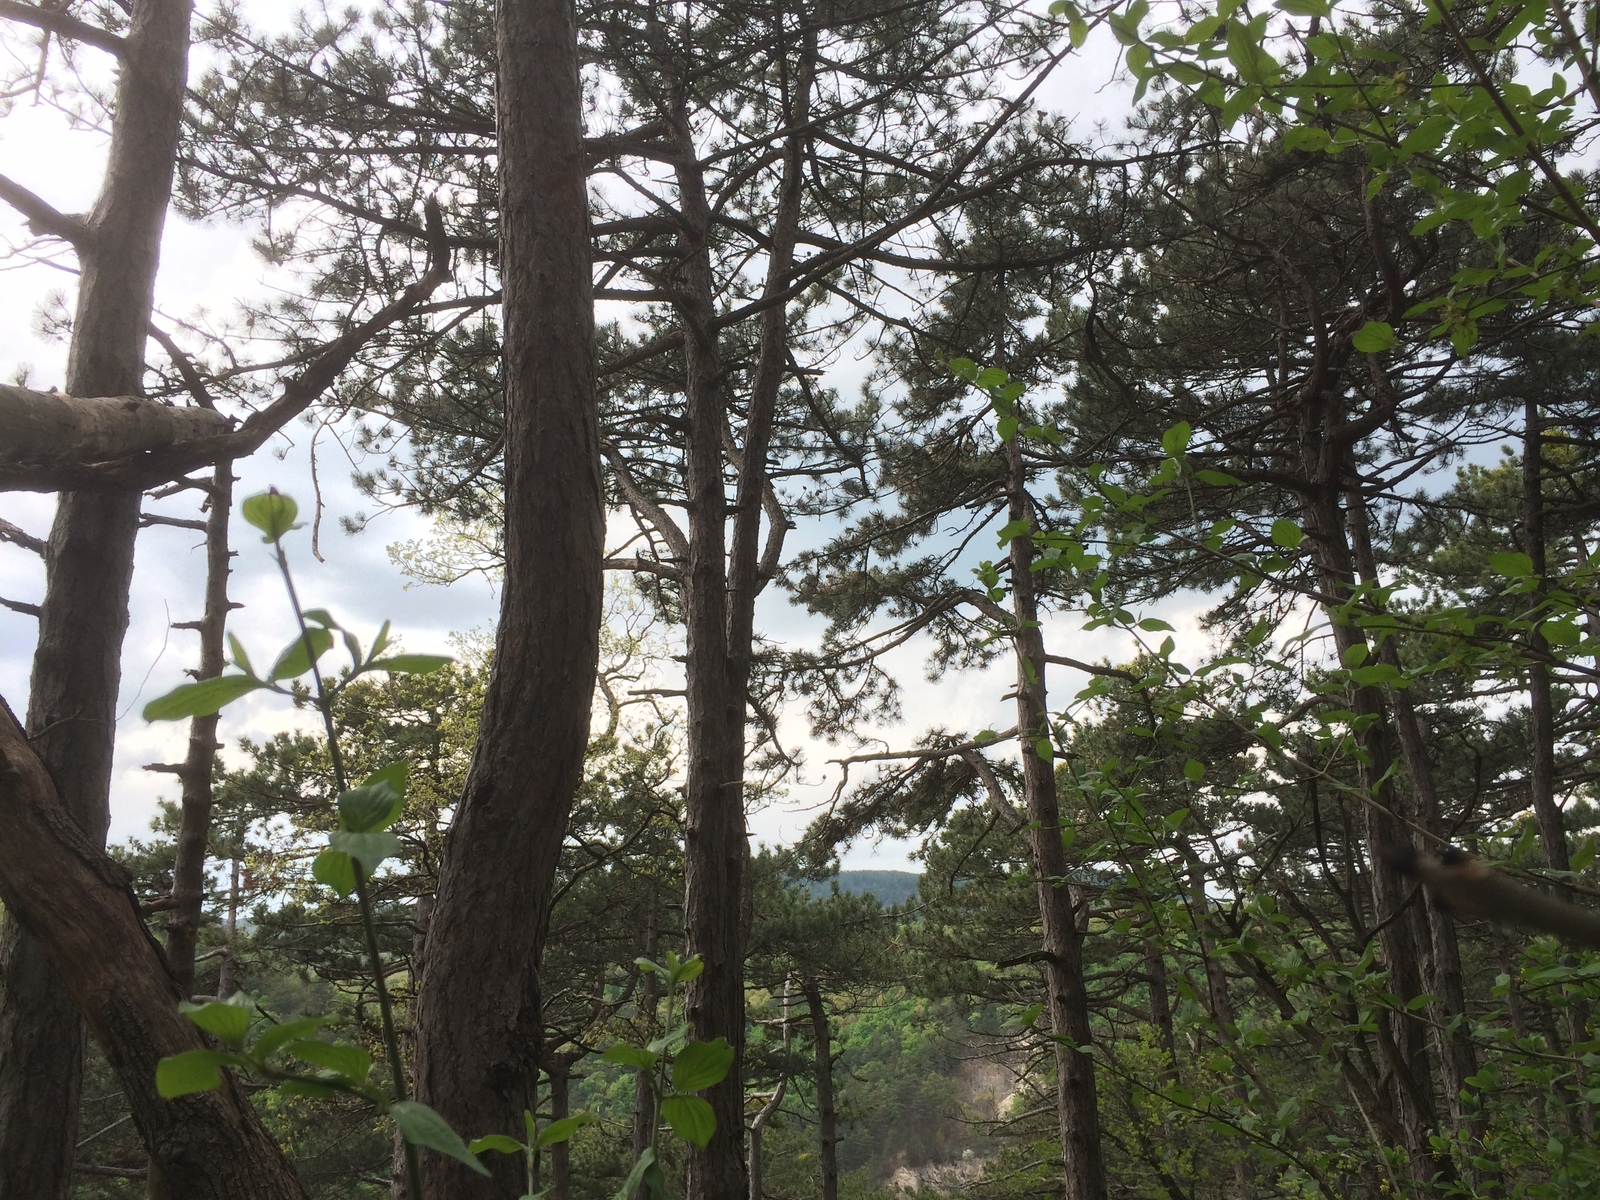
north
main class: Woodland
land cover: Pine dominated mixed woodland
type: alpine coniferous forest
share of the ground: > 75 %
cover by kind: coniferous forest trees 75 %, broadleaved forest trees 25 %
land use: Forestry
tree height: > 5 m
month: May
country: AT
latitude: 48.0661
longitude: 16.2175
